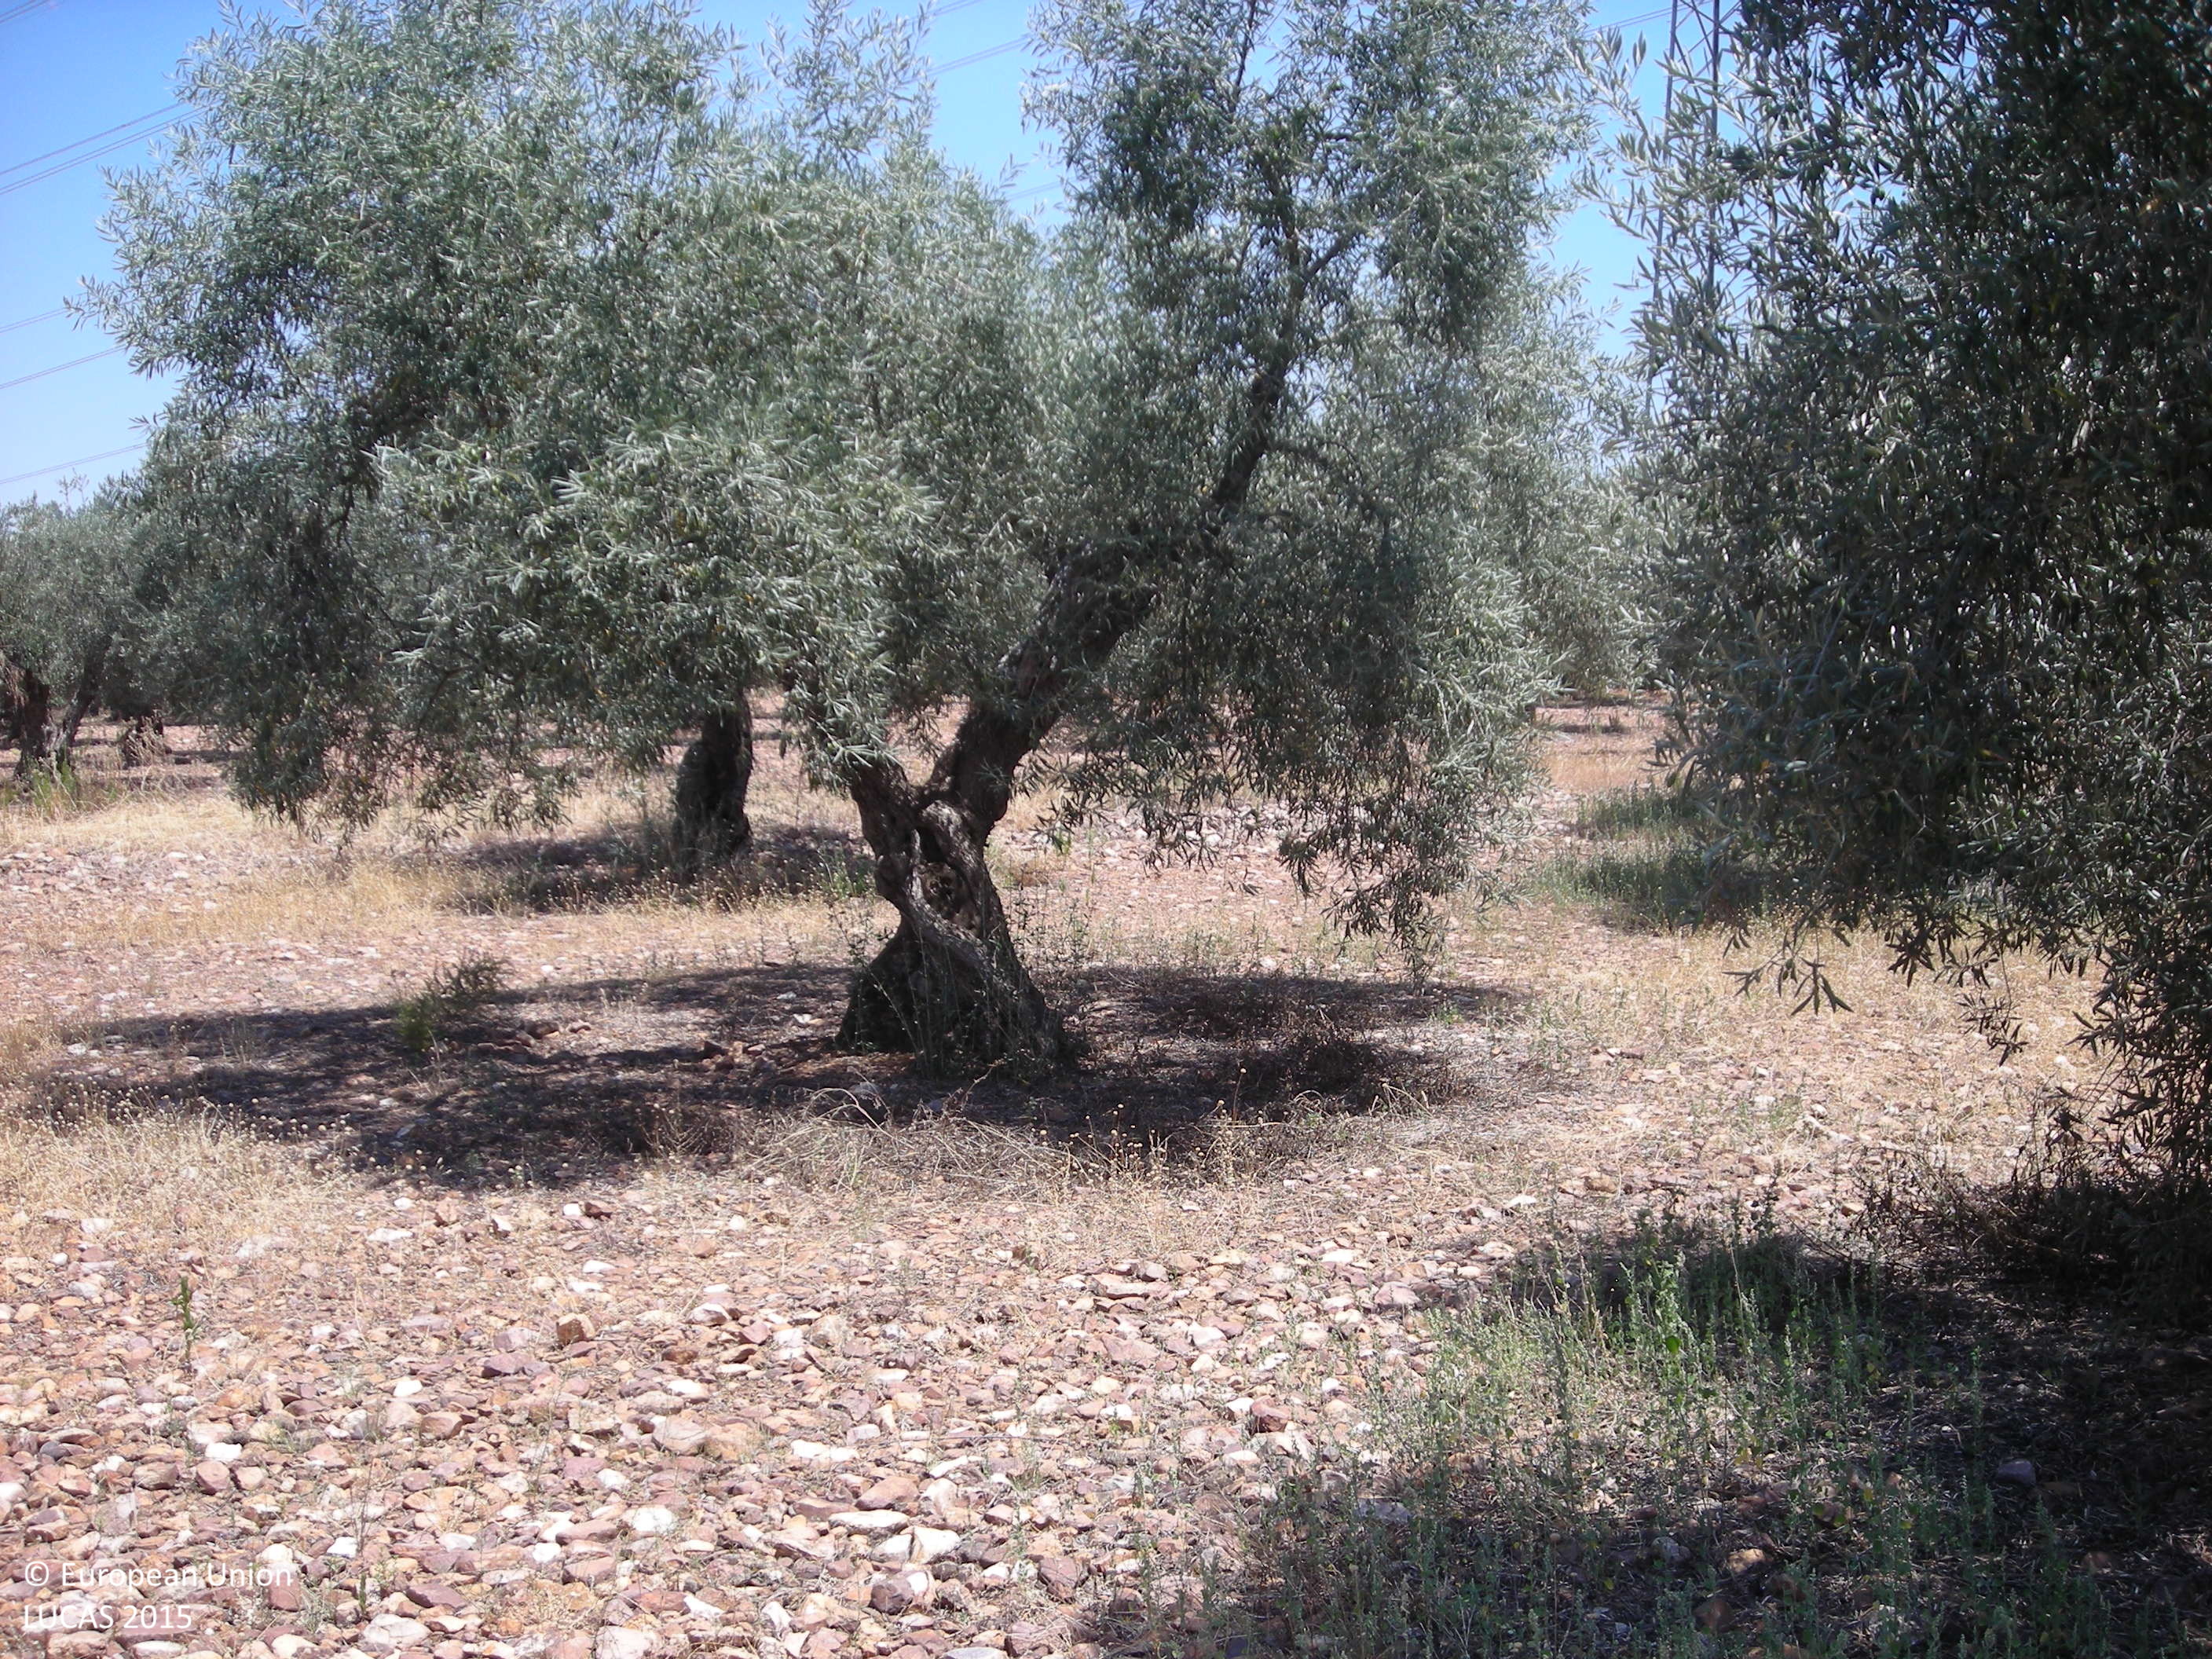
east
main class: Cropland
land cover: Olive groves
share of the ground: 50 - 75 %
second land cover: Grassland without tree/shrub cover
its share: 50 - 75 %
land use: Agriculture (excluding fallow land and kitchen gardens)
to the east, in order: Olive groves; Grassland without tree/shrub cover; Ditches and canals; Tracks; Ditches and canals; Electric lines; Olive groves
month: June
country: ES
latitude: 39.0784
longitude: -5.5236
